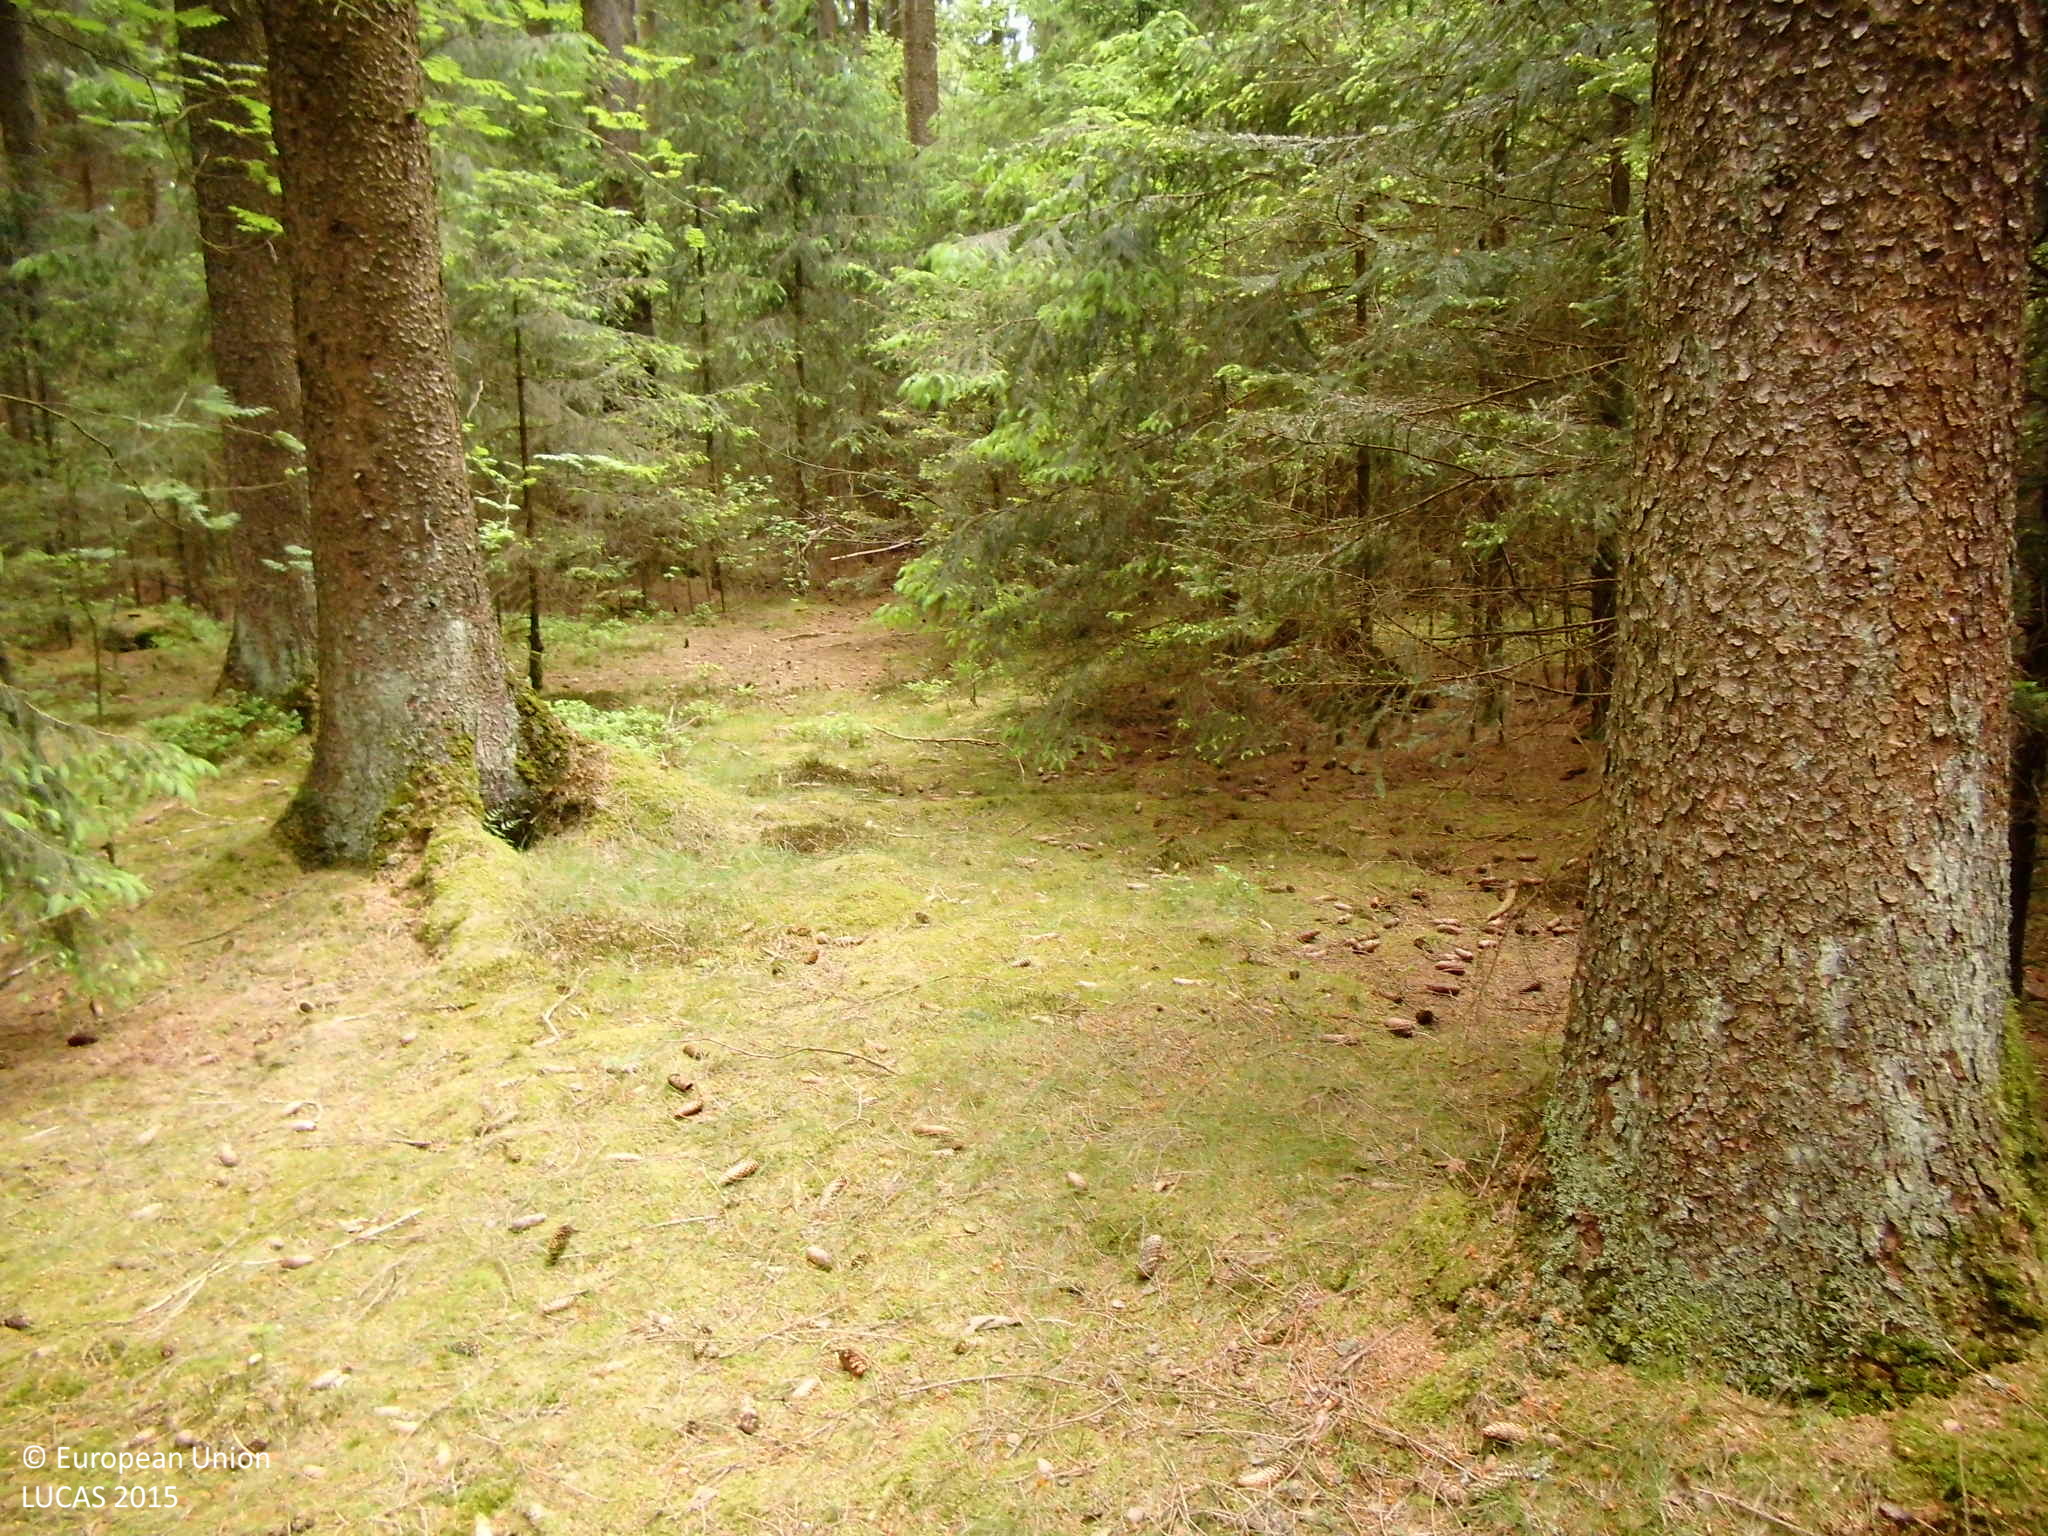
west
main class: Woodland
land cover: Spruce dominated coniferous woodland
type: hemiboreal forest and nemoral coniferous forest and mixed broadleaved-coniferous forest
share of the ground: > 75 %
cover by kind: coniferous forest trees 75 %, lichens and mosses 15 %, broadleaved forest trees 5 %, herbaceous plants 5 %
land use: Forestry
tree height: > 5 m
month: June
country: DE
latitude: 51.0478
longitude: 7.9891
